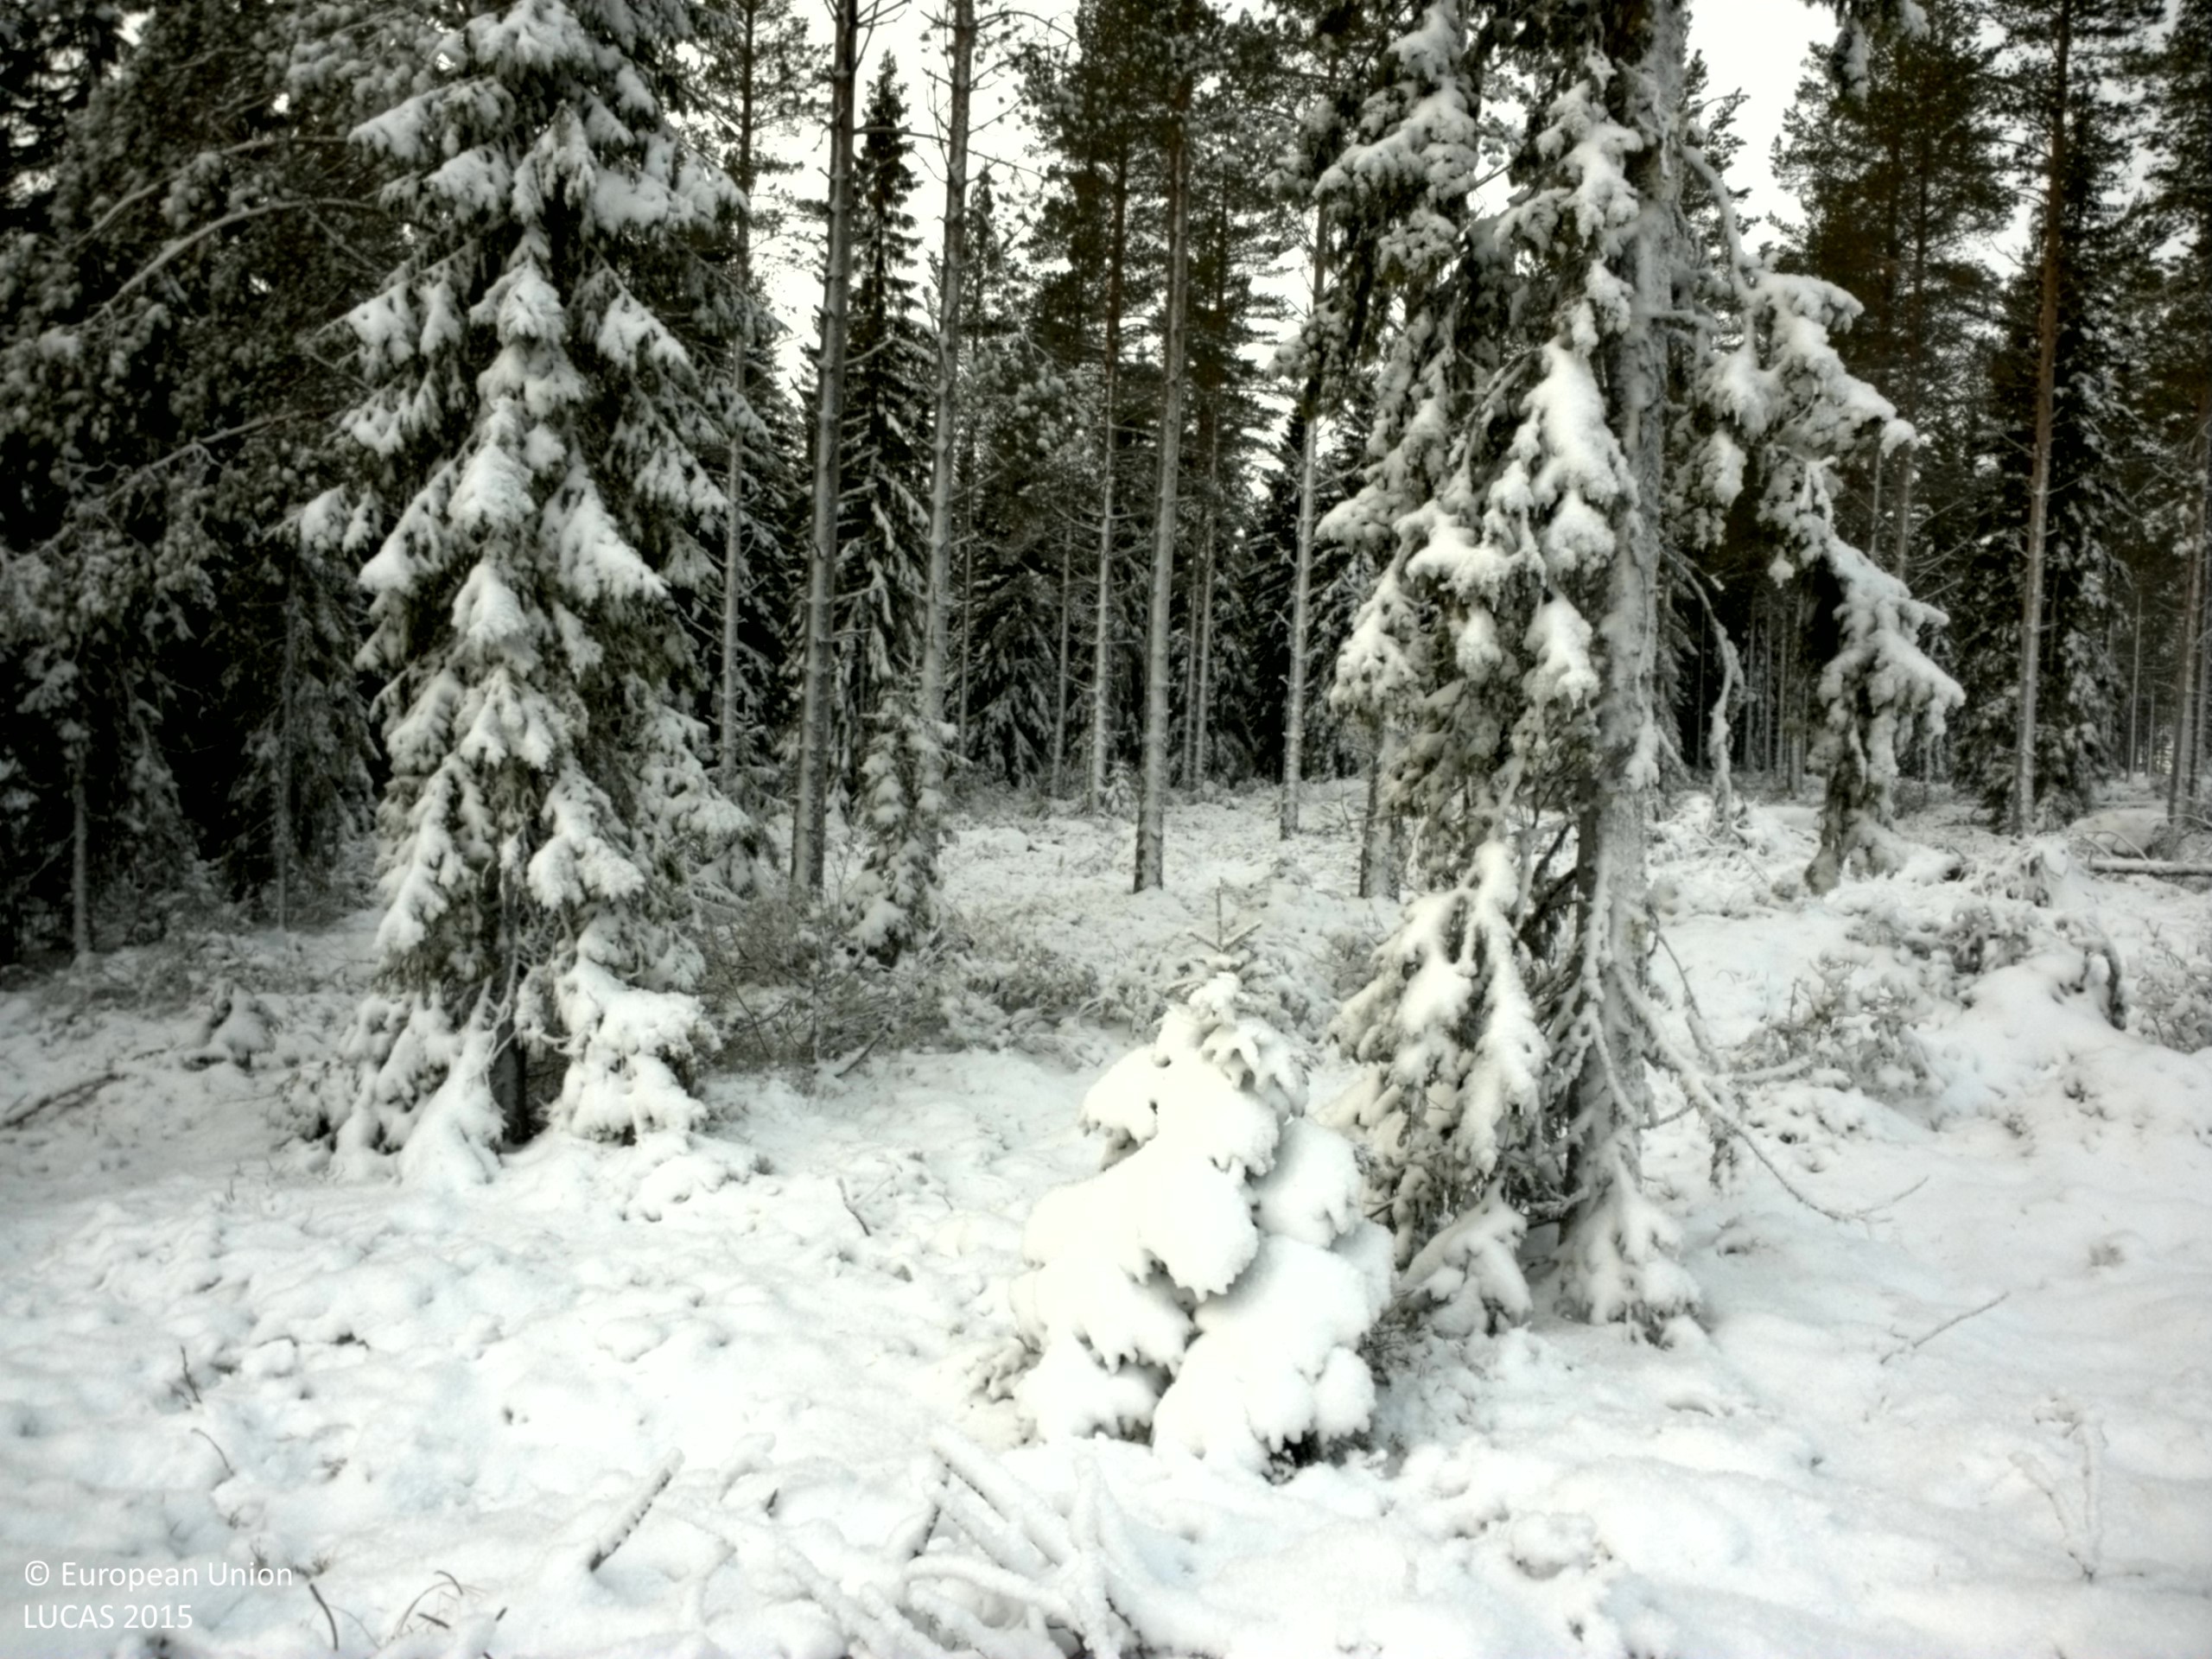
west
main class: Woodland
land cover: Other mixed woodland
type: boreal forest
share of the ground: 10 - 25 %
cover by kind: shrubs 35 %, lichens and mosses 30 %, herbaceous plants 15 %, coniferous forest trees 5 %, broadleaved forest trees 5 %, consolidated bare surface 5 %, unconsolidated bare surface 5 %
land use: Forestry
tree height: < 5 m
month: November
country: SE
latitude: 61.8801
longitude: 15.4789
